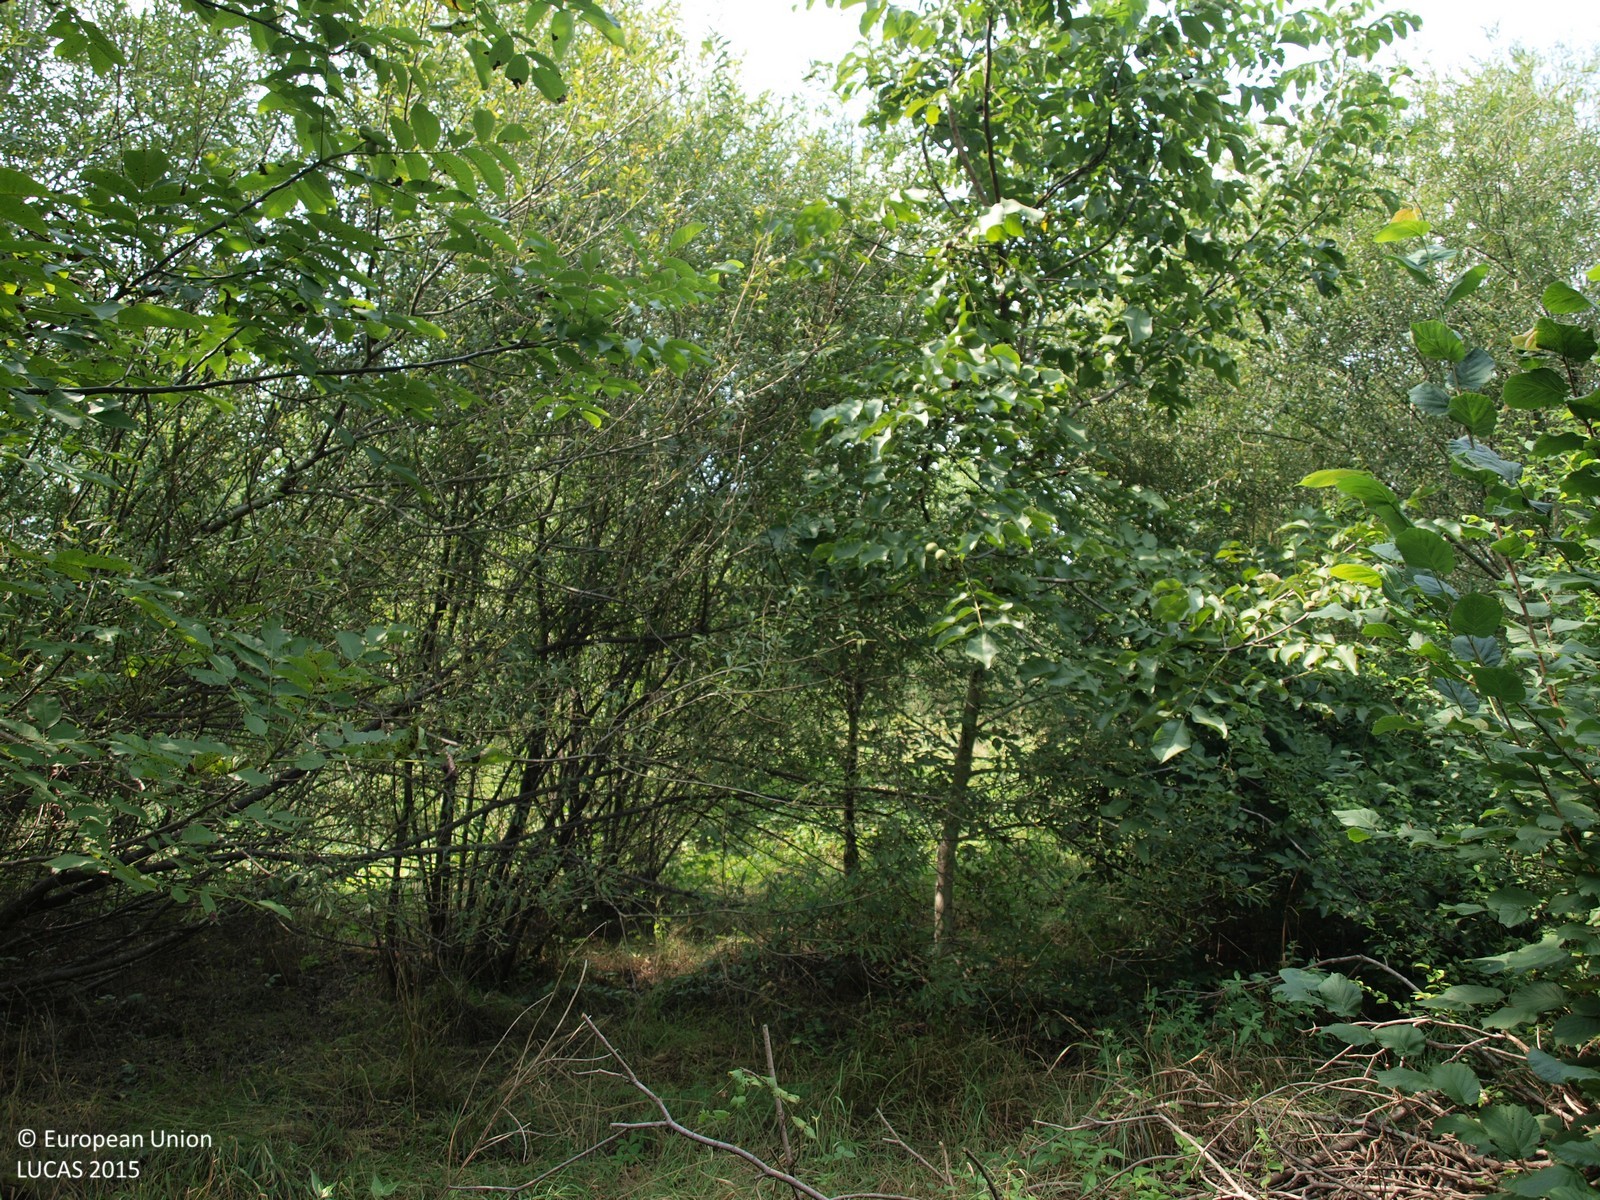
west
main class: Shrubland
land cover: Shrubland with sparse tree cover
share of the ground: > 75 %
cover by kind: shrubs 95 %, broadleaved forest trees 5 %
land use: Semi-natural and natural areas not in use
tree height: > 5 m
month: August
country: HR
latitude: 45.6806
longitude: 16.2506
